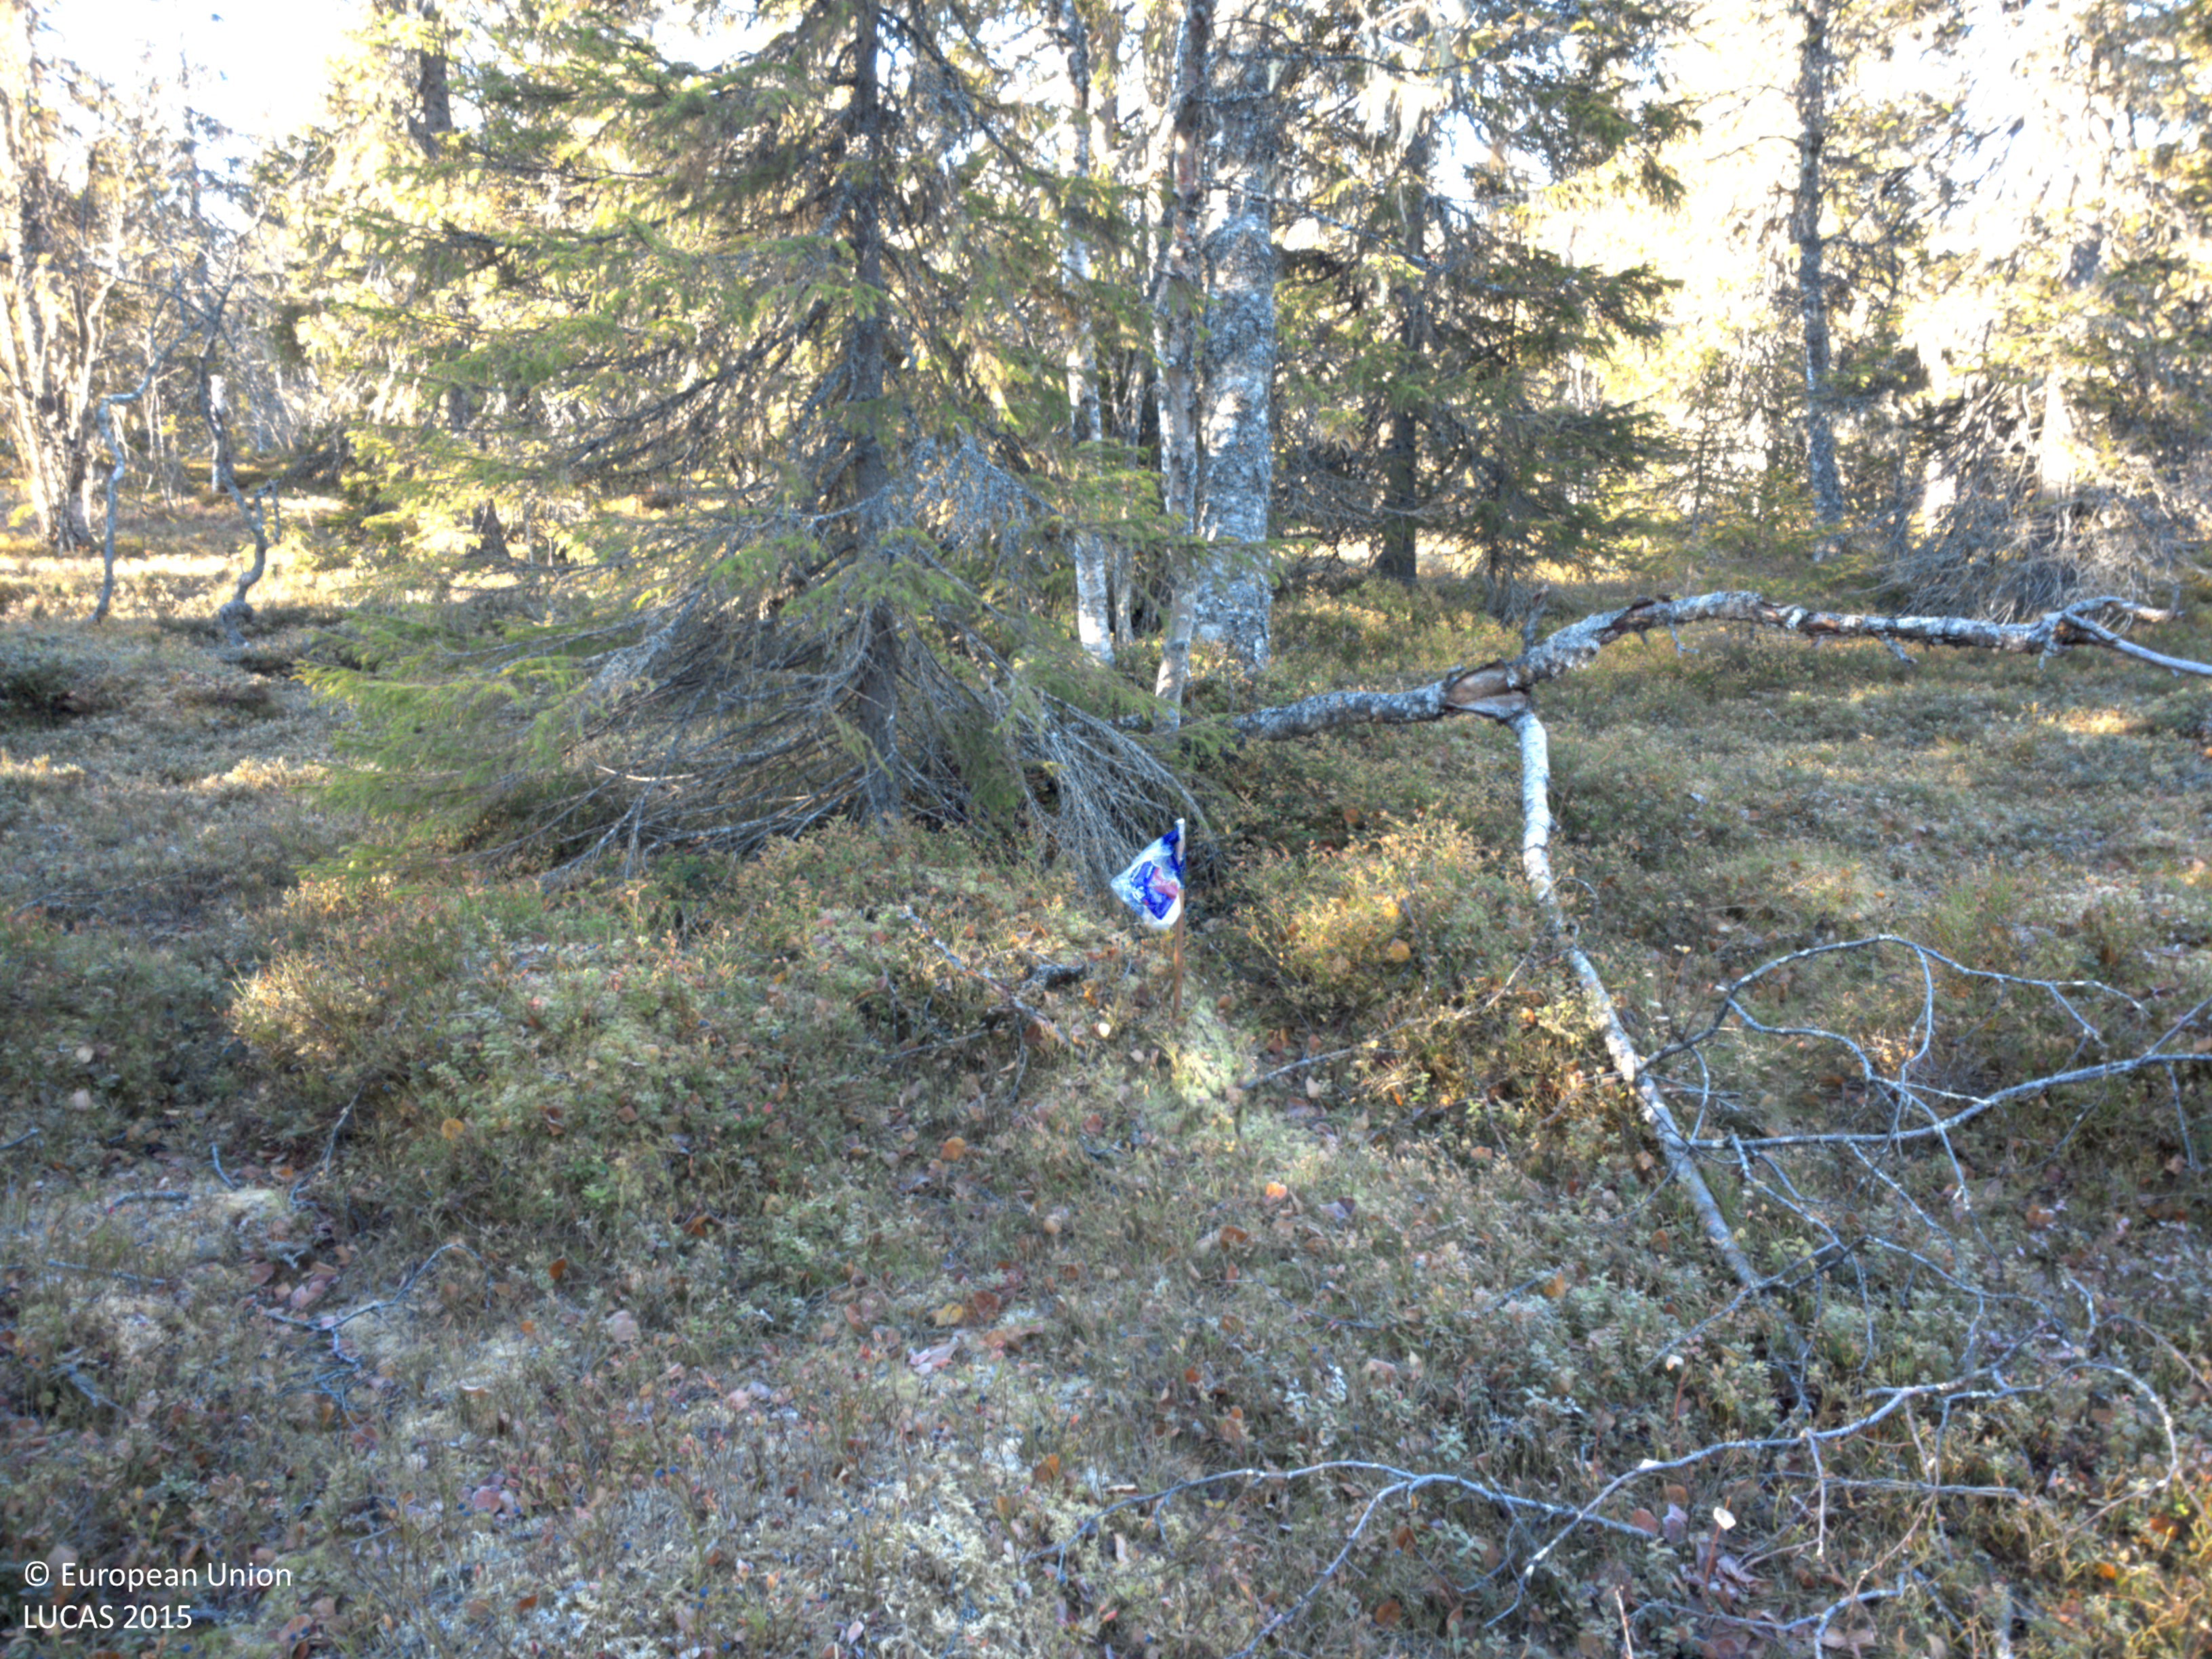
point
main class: Woodland
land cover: Spruce dominated mixed woodland
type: boreal forest
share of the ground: 25 - 50 %
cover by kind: coniferous forest trees 35 %, shrubs 30 %, broadleaved forest trees 15 %, lichens and mosses 15 %, herbaceous plants 5 %
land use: Forestry
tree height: > 5 m
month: October
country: SE
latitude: 64.5518
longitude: 17.7887
